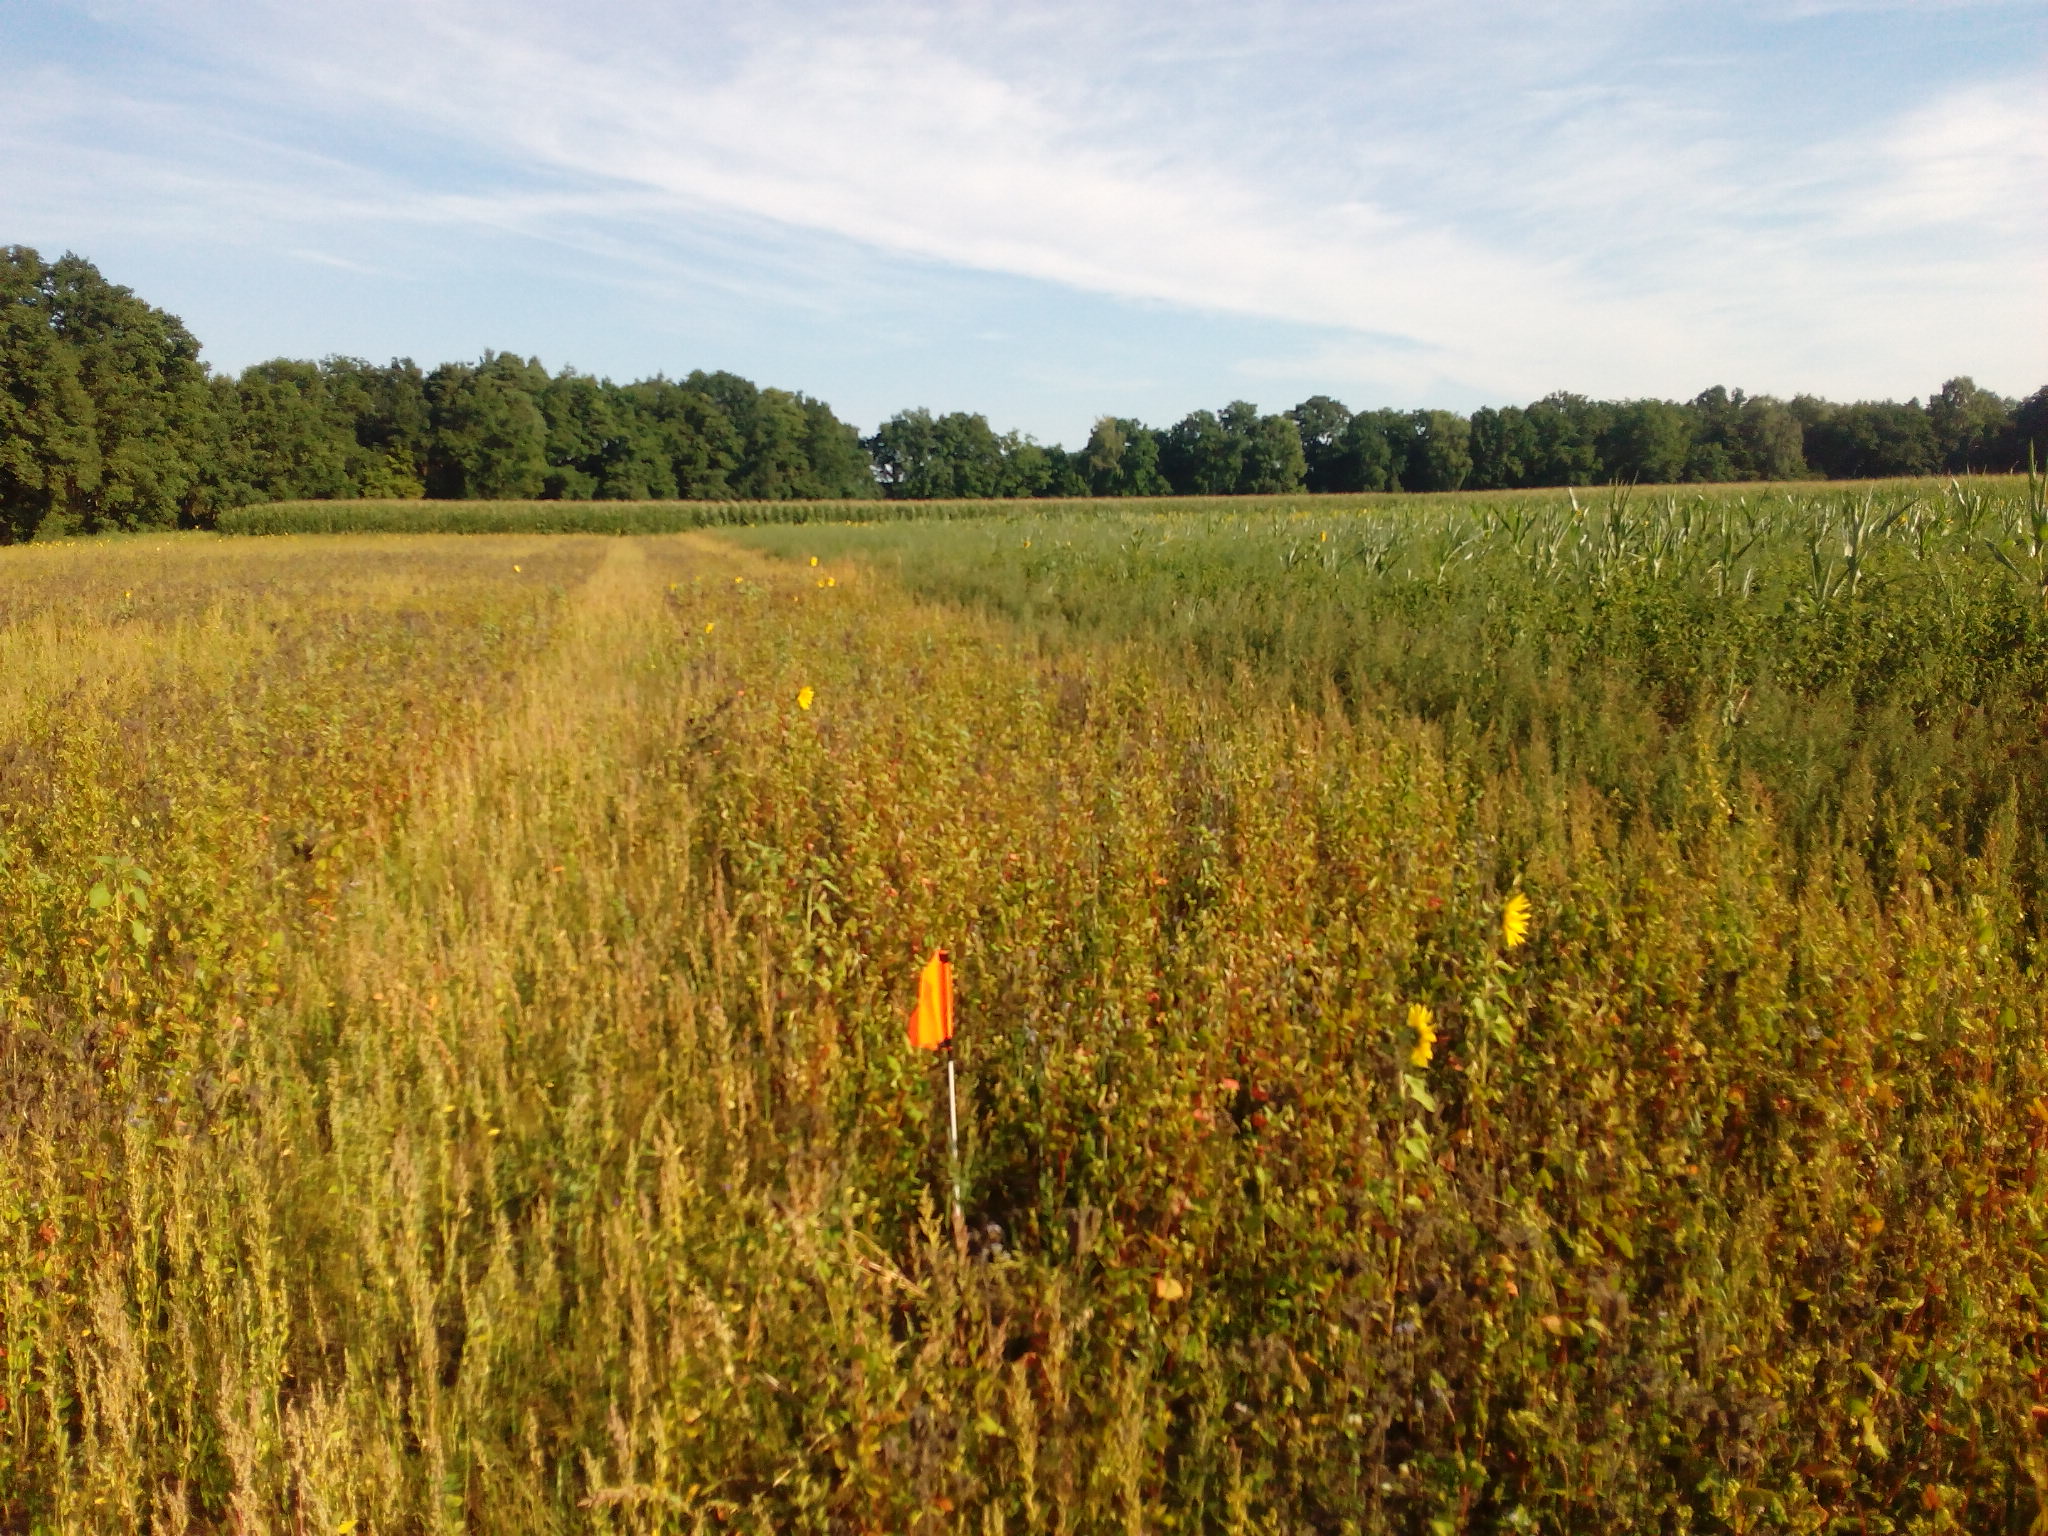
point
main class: Cropland
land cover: Lucerne
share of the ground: > 75 %
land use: Agriculture (excluding fallow land and kitchen gardens)
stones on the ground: < 10 %
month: August
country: DE
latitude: 52.5571
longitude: 9.8673
